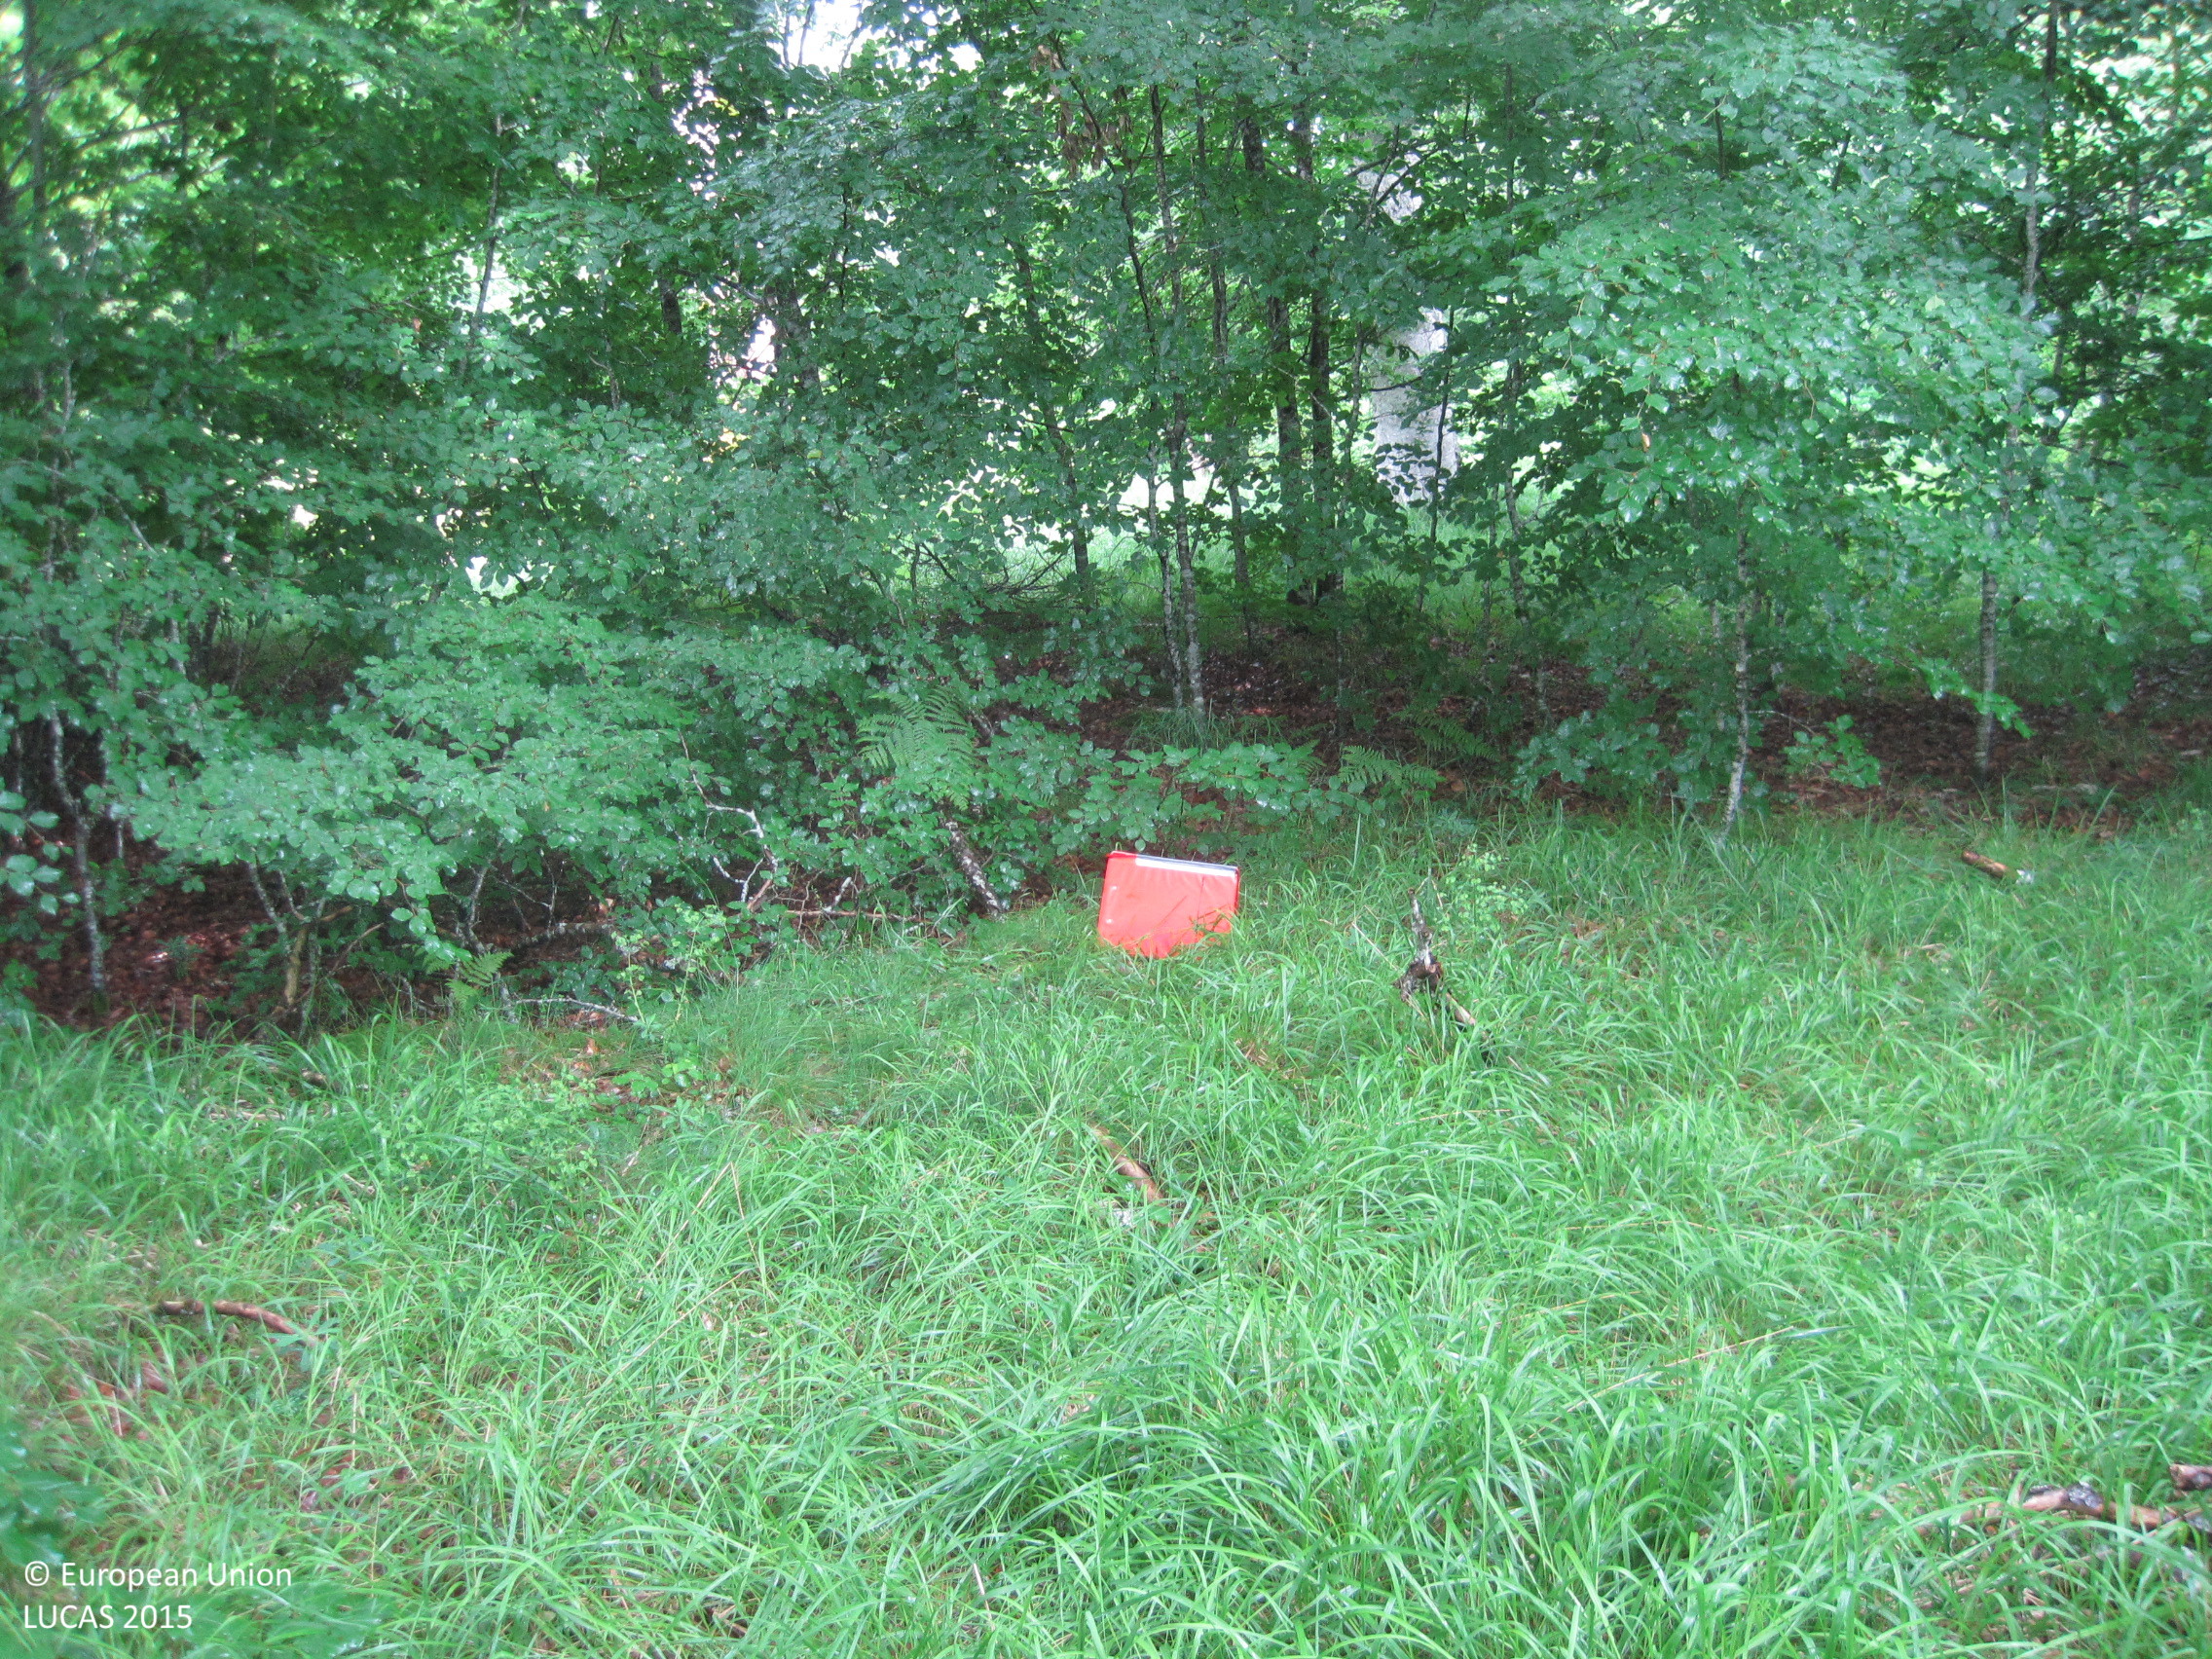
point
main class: Woodland
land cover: Broadleaved woodland
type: beech forest
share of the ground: > 75 %
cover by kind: broadleaved forest trees 95 %, herbaceous plants 5 %
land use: Forestry
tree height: > 5 m
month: June
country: ES
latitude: 42.7881
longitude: -2.2087
